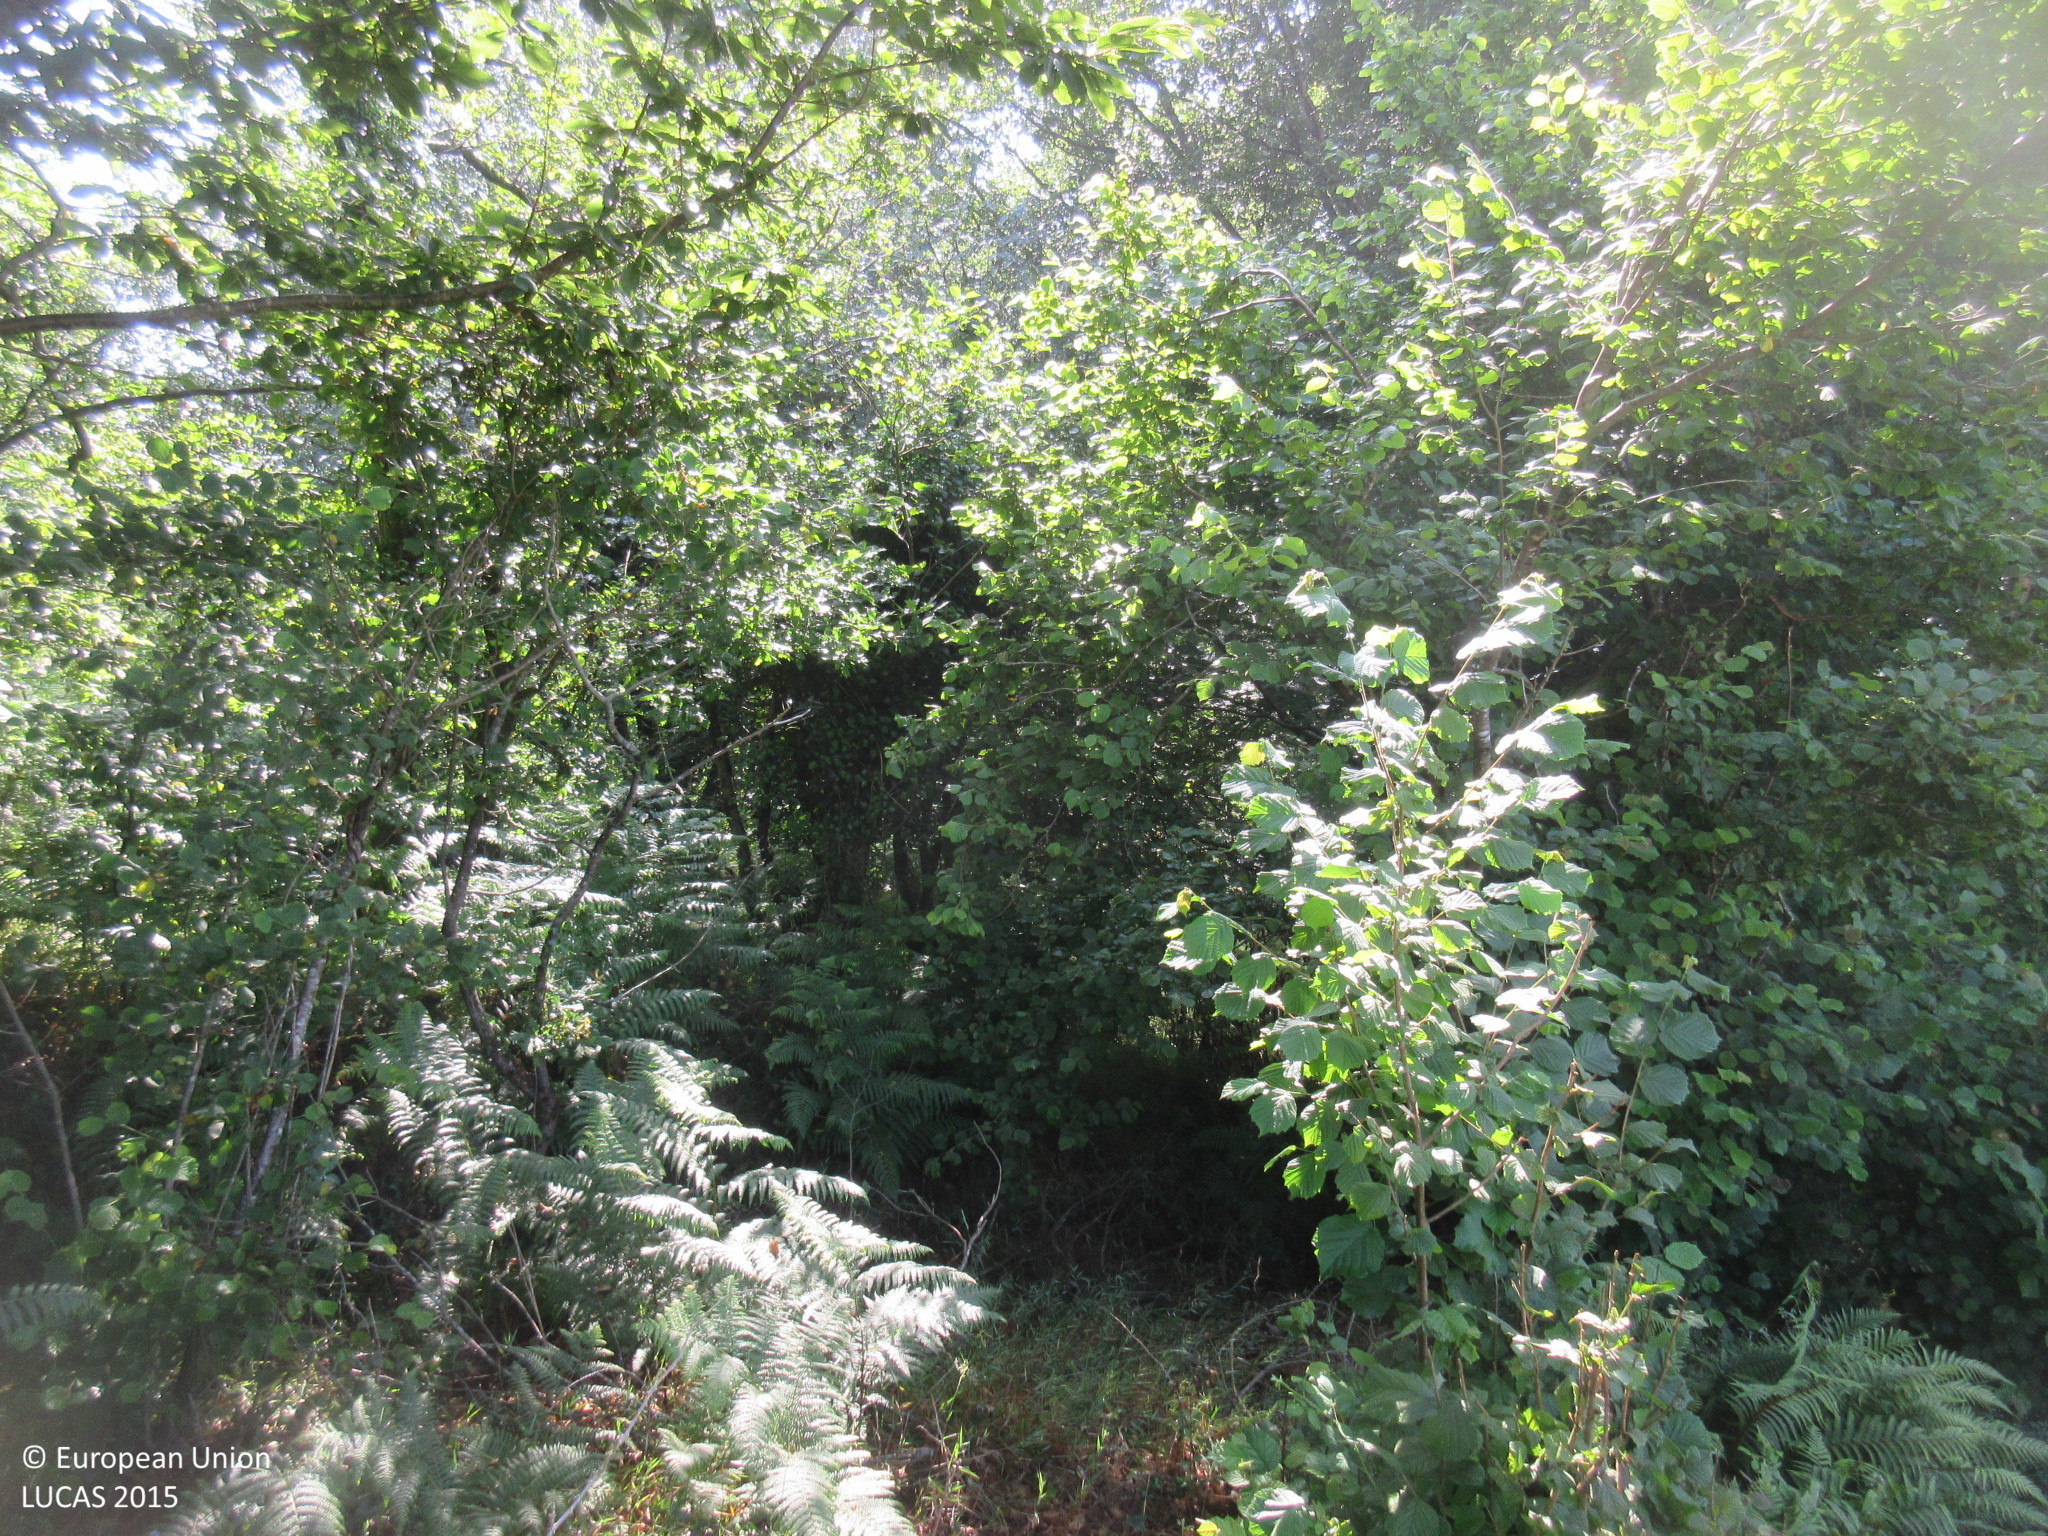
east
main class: Woodland
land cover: Broadleaved woodland
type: thermophilous deciduous forest
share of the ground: > 75 %
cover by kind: broadleaved forest trees 95 %, shrubs 5 %
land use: Forestry
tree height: > 5 m
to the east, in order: Broadleaved woodland; Fences; Grassland without tree/shrub cover; Fences; Grassland without tree/shrub cover; Fences; Grassland without tree/shrub cover; Fences; Groves; Grassland without tree/shrub cover; Fences; Grassland with sparse tree/shrub cover
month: July
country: ES
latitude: 43.3694
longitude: -6.3778
